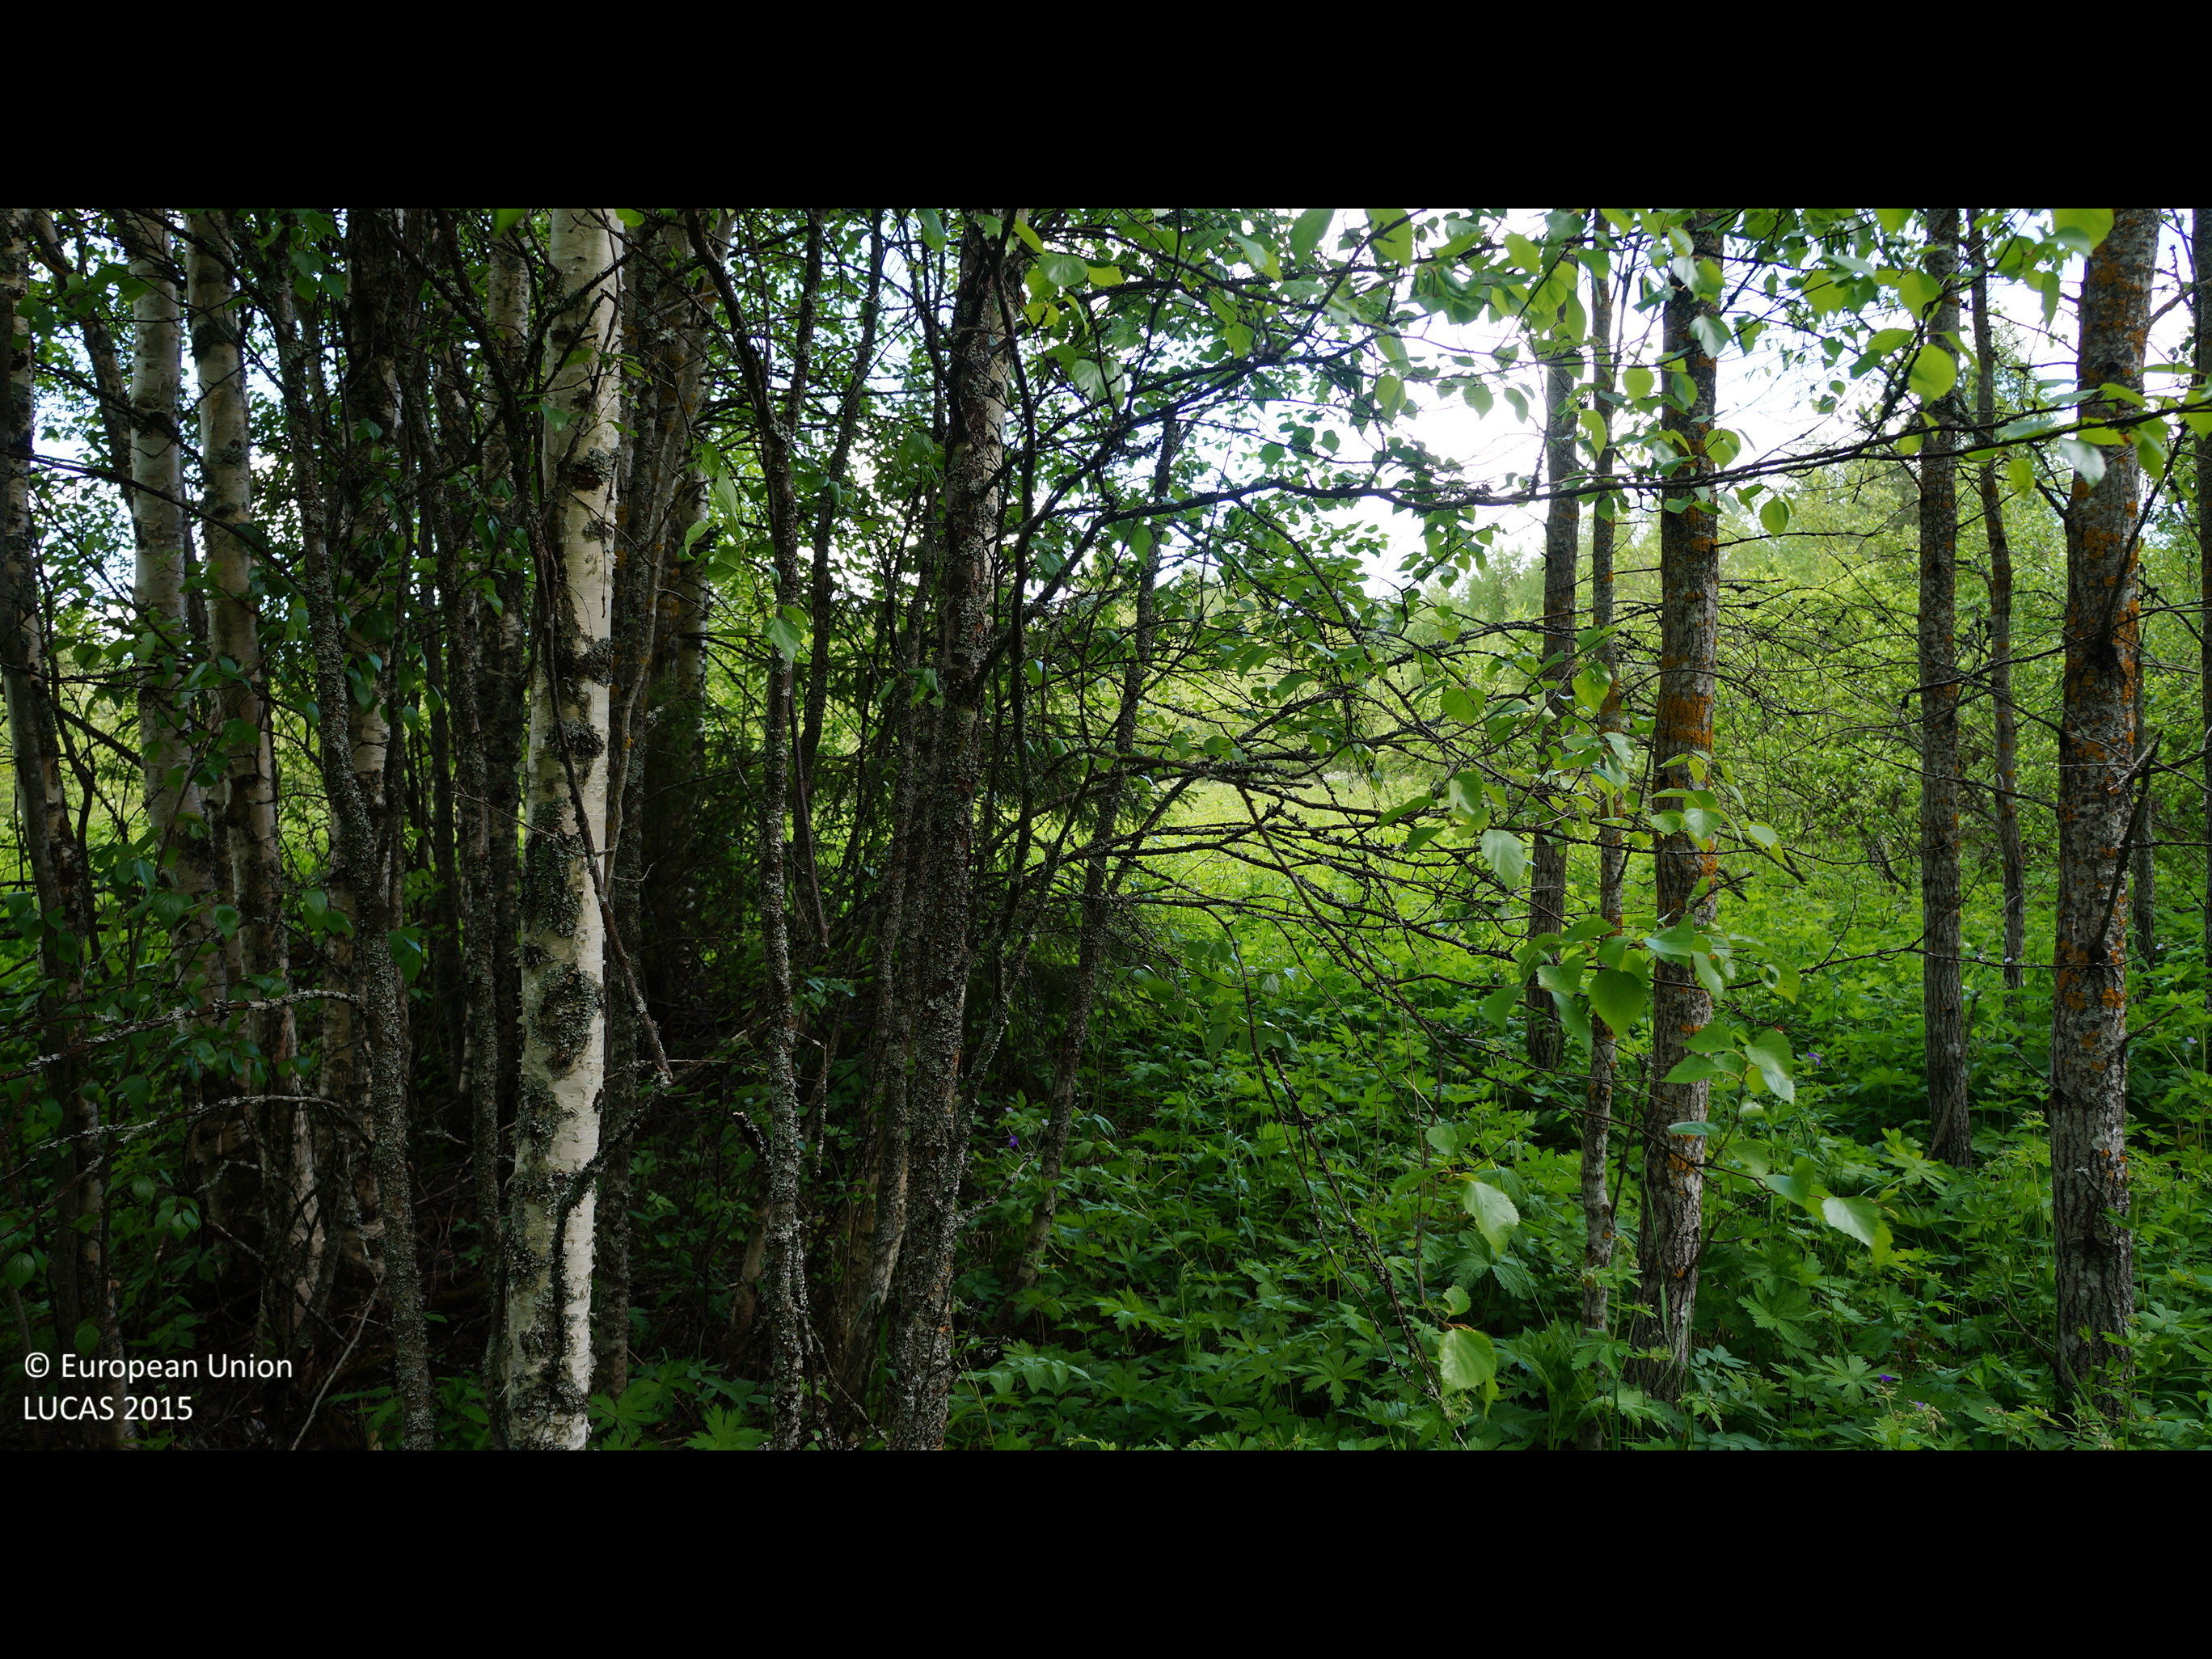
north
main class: Woodland
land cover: Broadleaved woodland
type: boreal forest
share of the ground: 50 - 75 %
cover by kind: broadleaved forest trees 50 %, herbaceous plants 30 %, shrubs 20 %
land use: Forestry
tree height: > 5 m
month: June
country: FI
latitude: 64.1466
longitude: 25.3202
